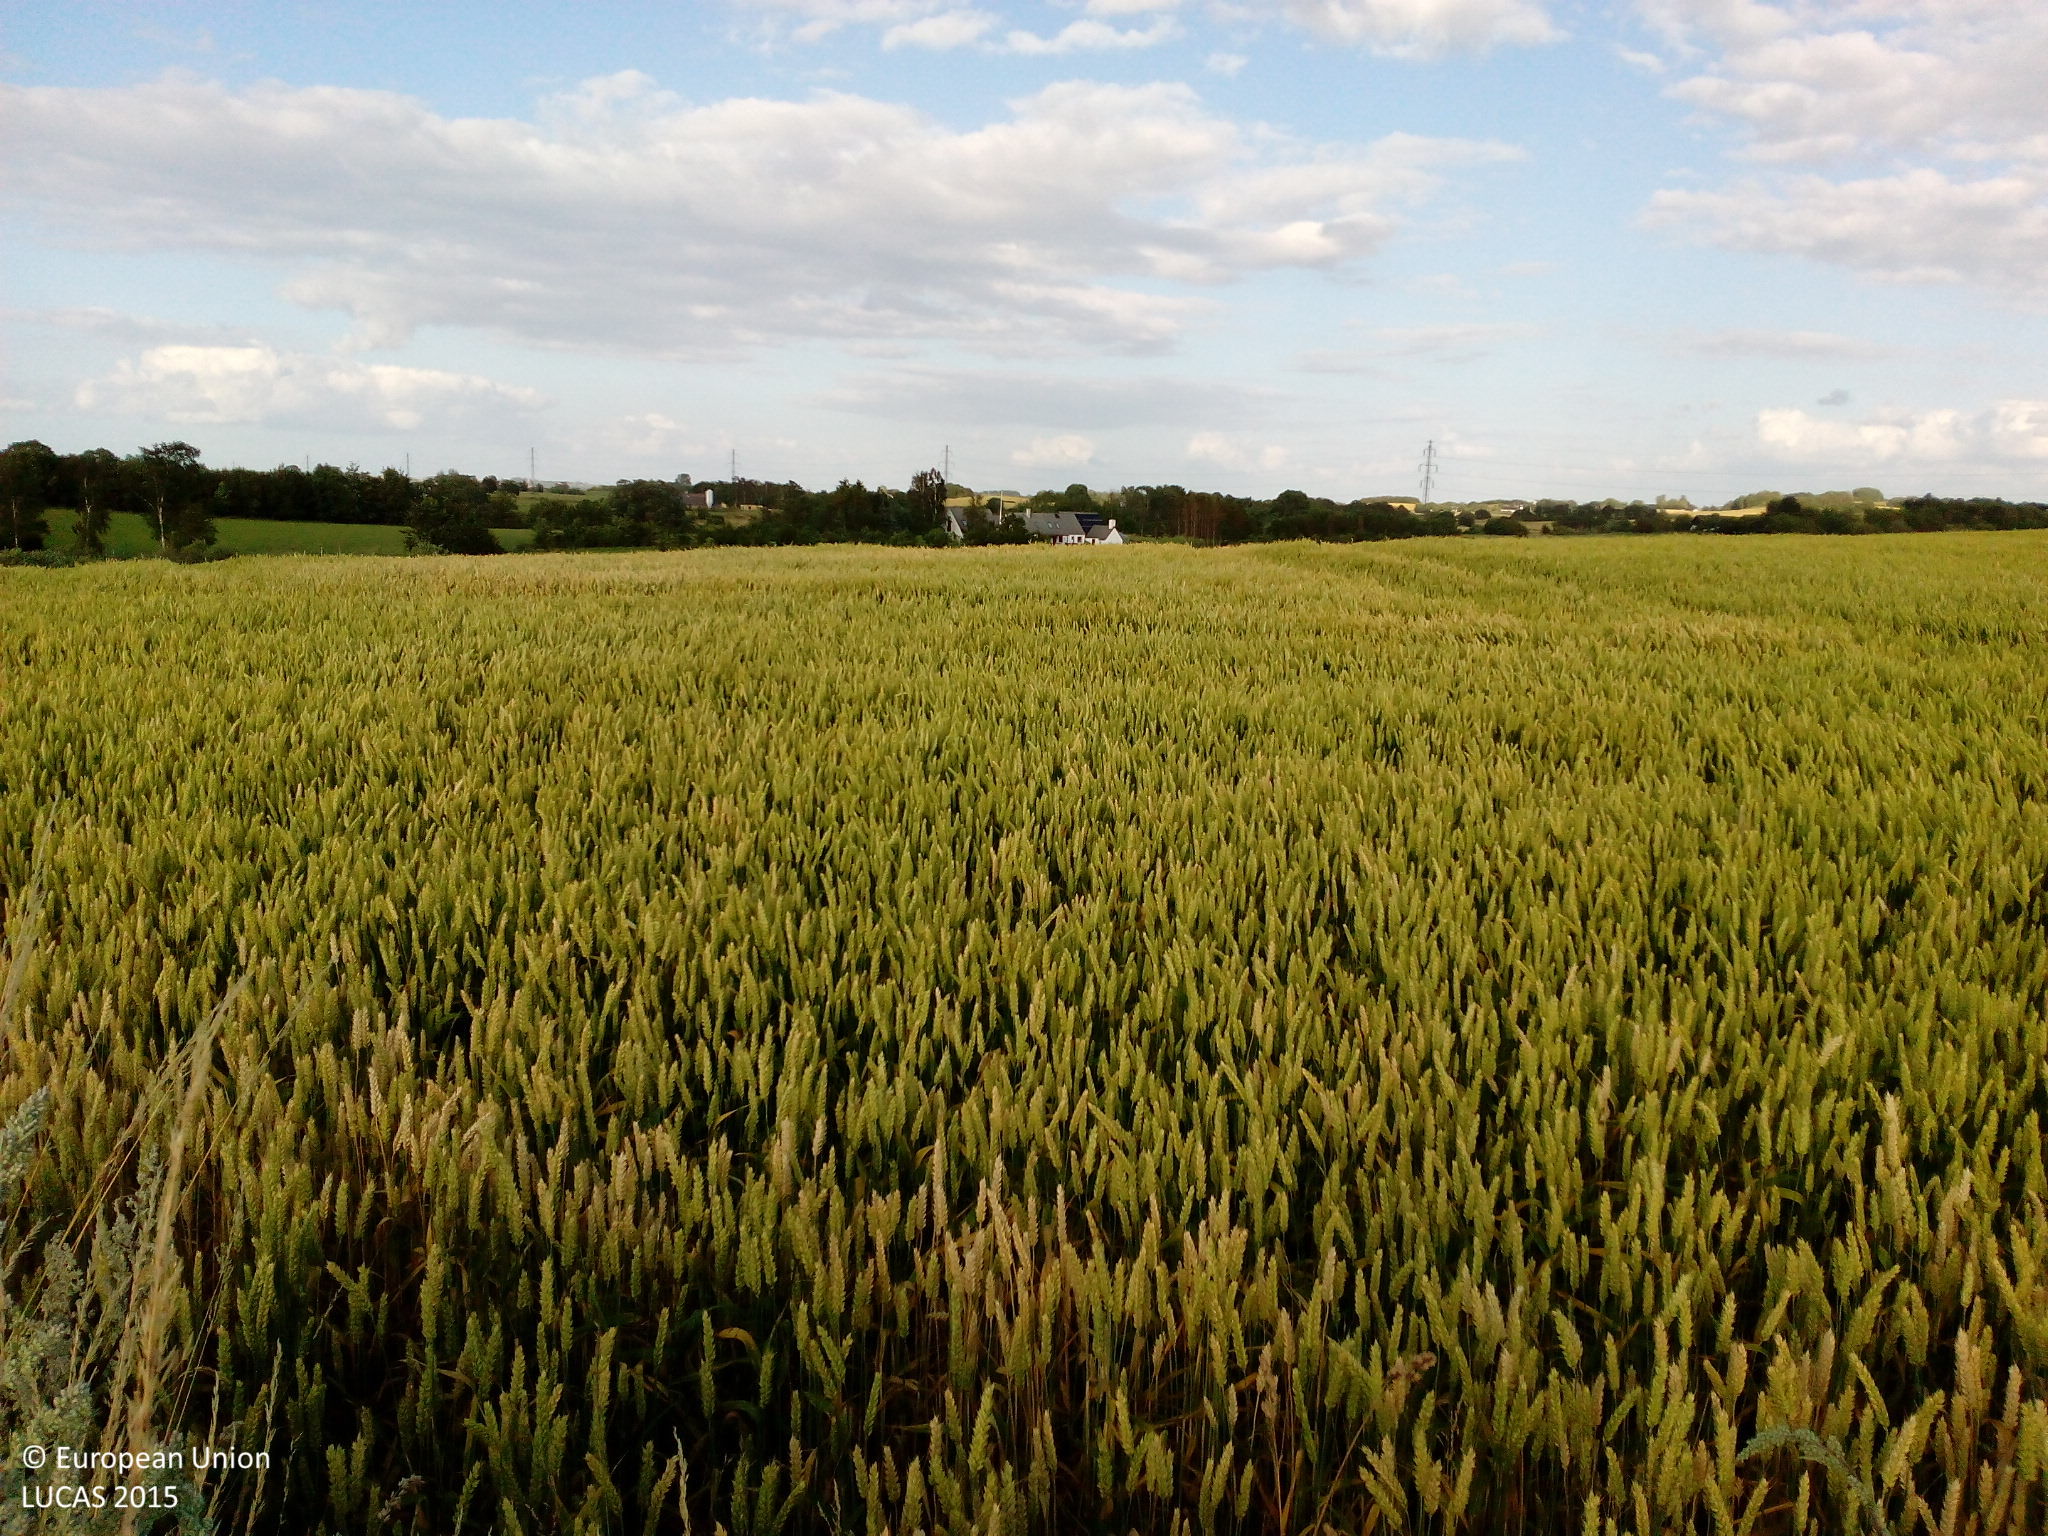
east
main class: Cropland
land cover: Common wheat
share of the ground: > 75 %
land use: Agriculture (excluding fallow land and kitchen gardens)
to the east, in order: Common wheat; Shrubland with sparse tree cover; Broadleaved woodland; Grassland without tree/shrub cover; Broadleaved woodland; Grassland without tree/shrub cover
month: July
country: DK
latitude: 55.8189
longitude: 11.5466
